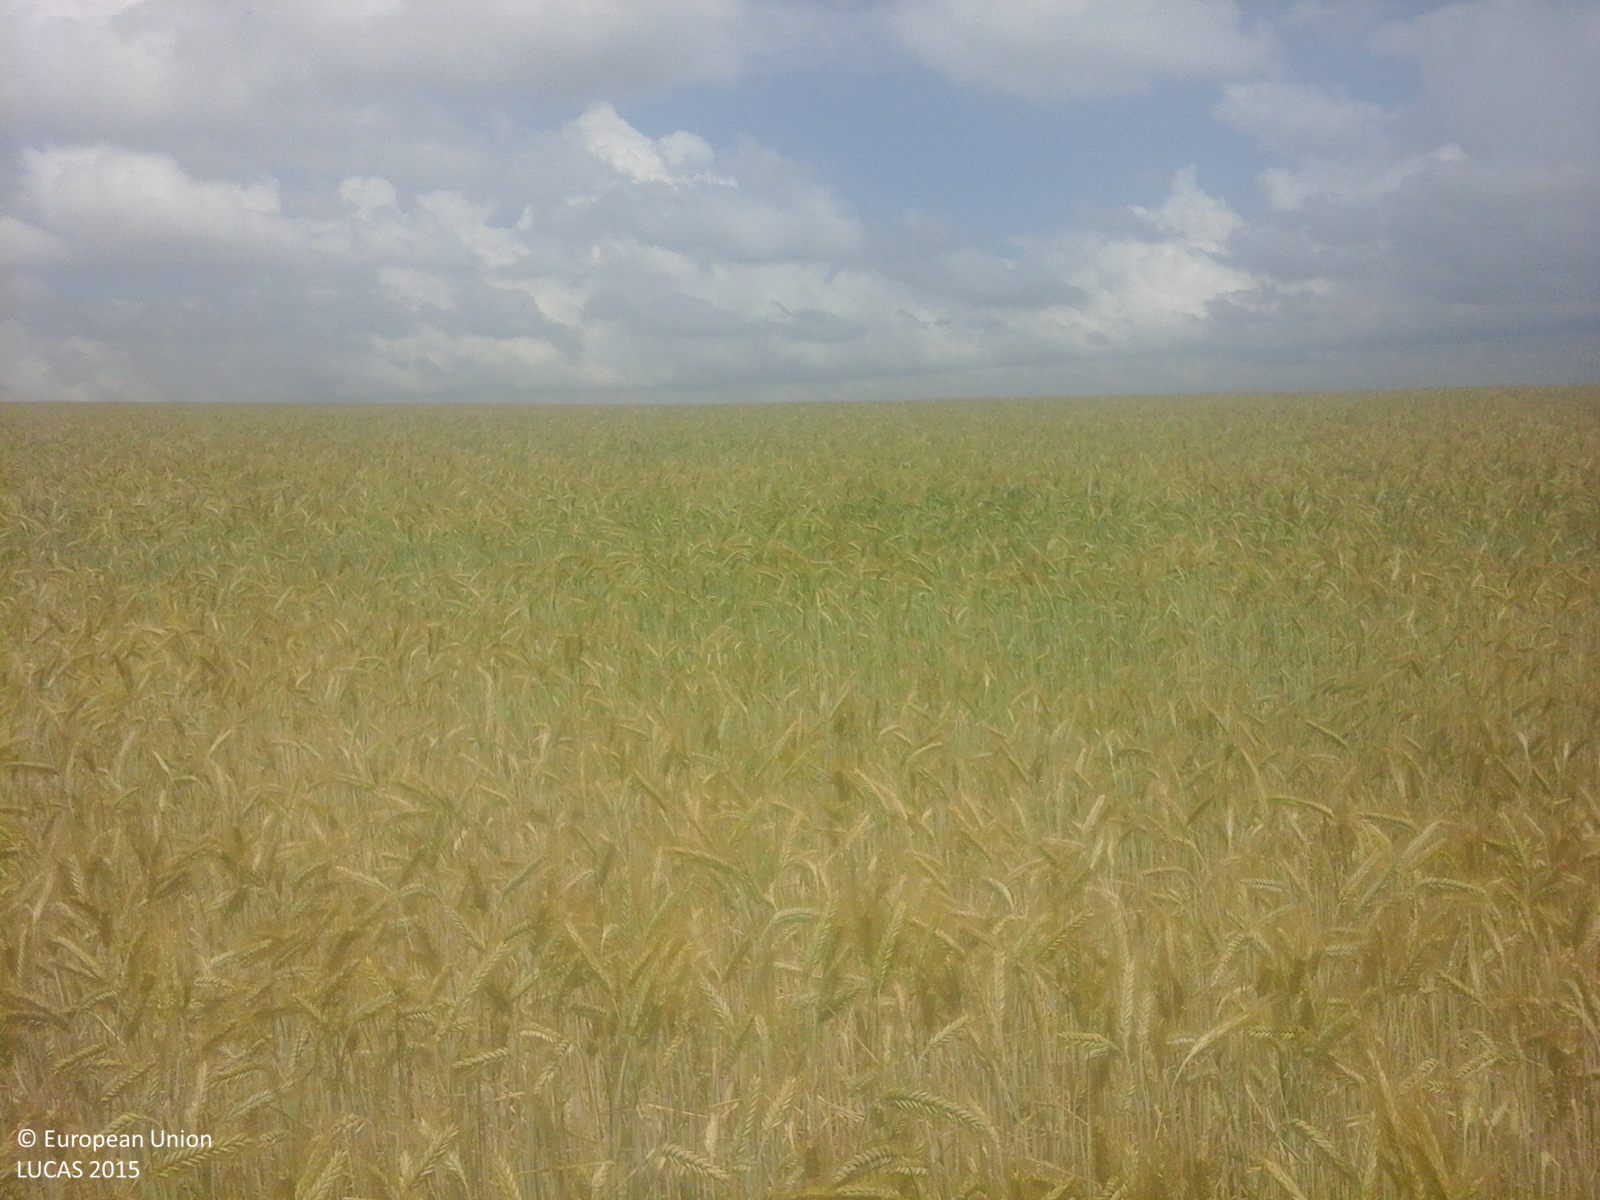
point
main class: Cropland
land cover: Common wheat
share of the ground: > 75 %
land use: Agriculture (excluding fallow land and kitchen gardens)
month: June
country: RO
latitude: 46.9955
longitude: 26.5643
